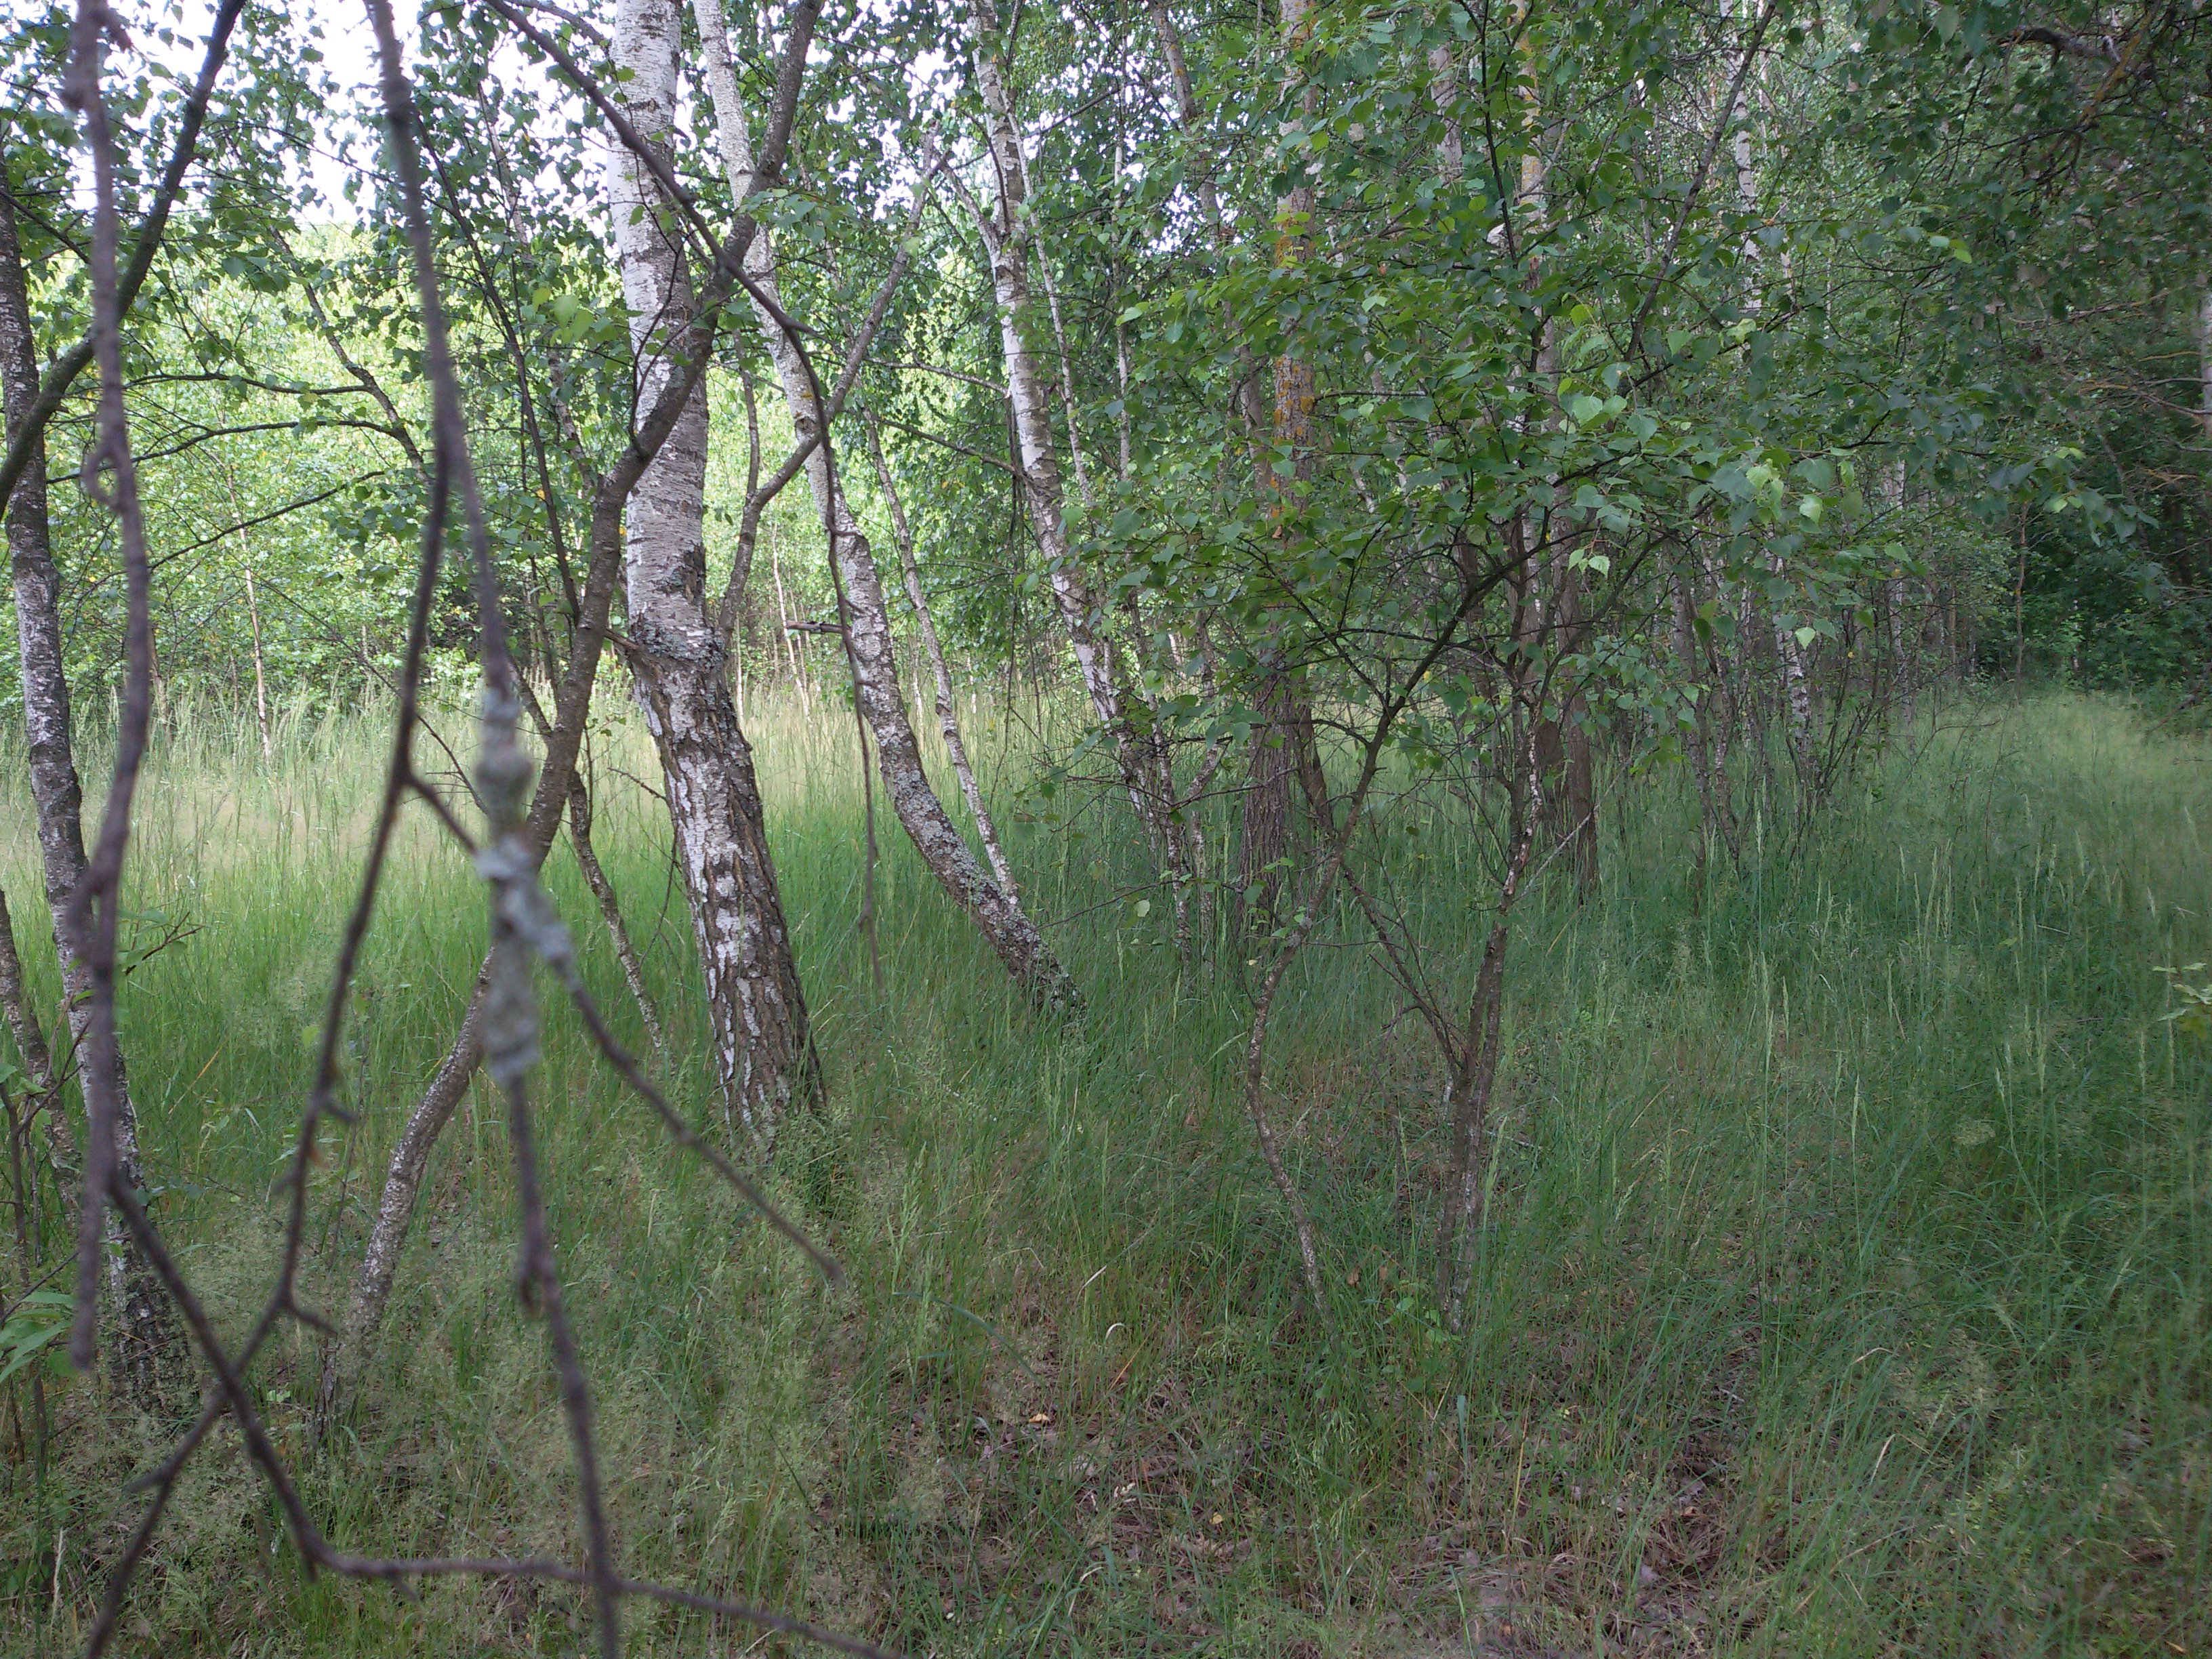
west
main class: Woodland
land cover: Broadleaved woodland
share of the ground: > 75 %
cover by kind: broadleaved forest trees 90 %, herbaceous plants 10 %
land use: Forestry
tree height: > 5 m
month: June
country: PL
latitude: 51.7631
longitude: 23.0438
